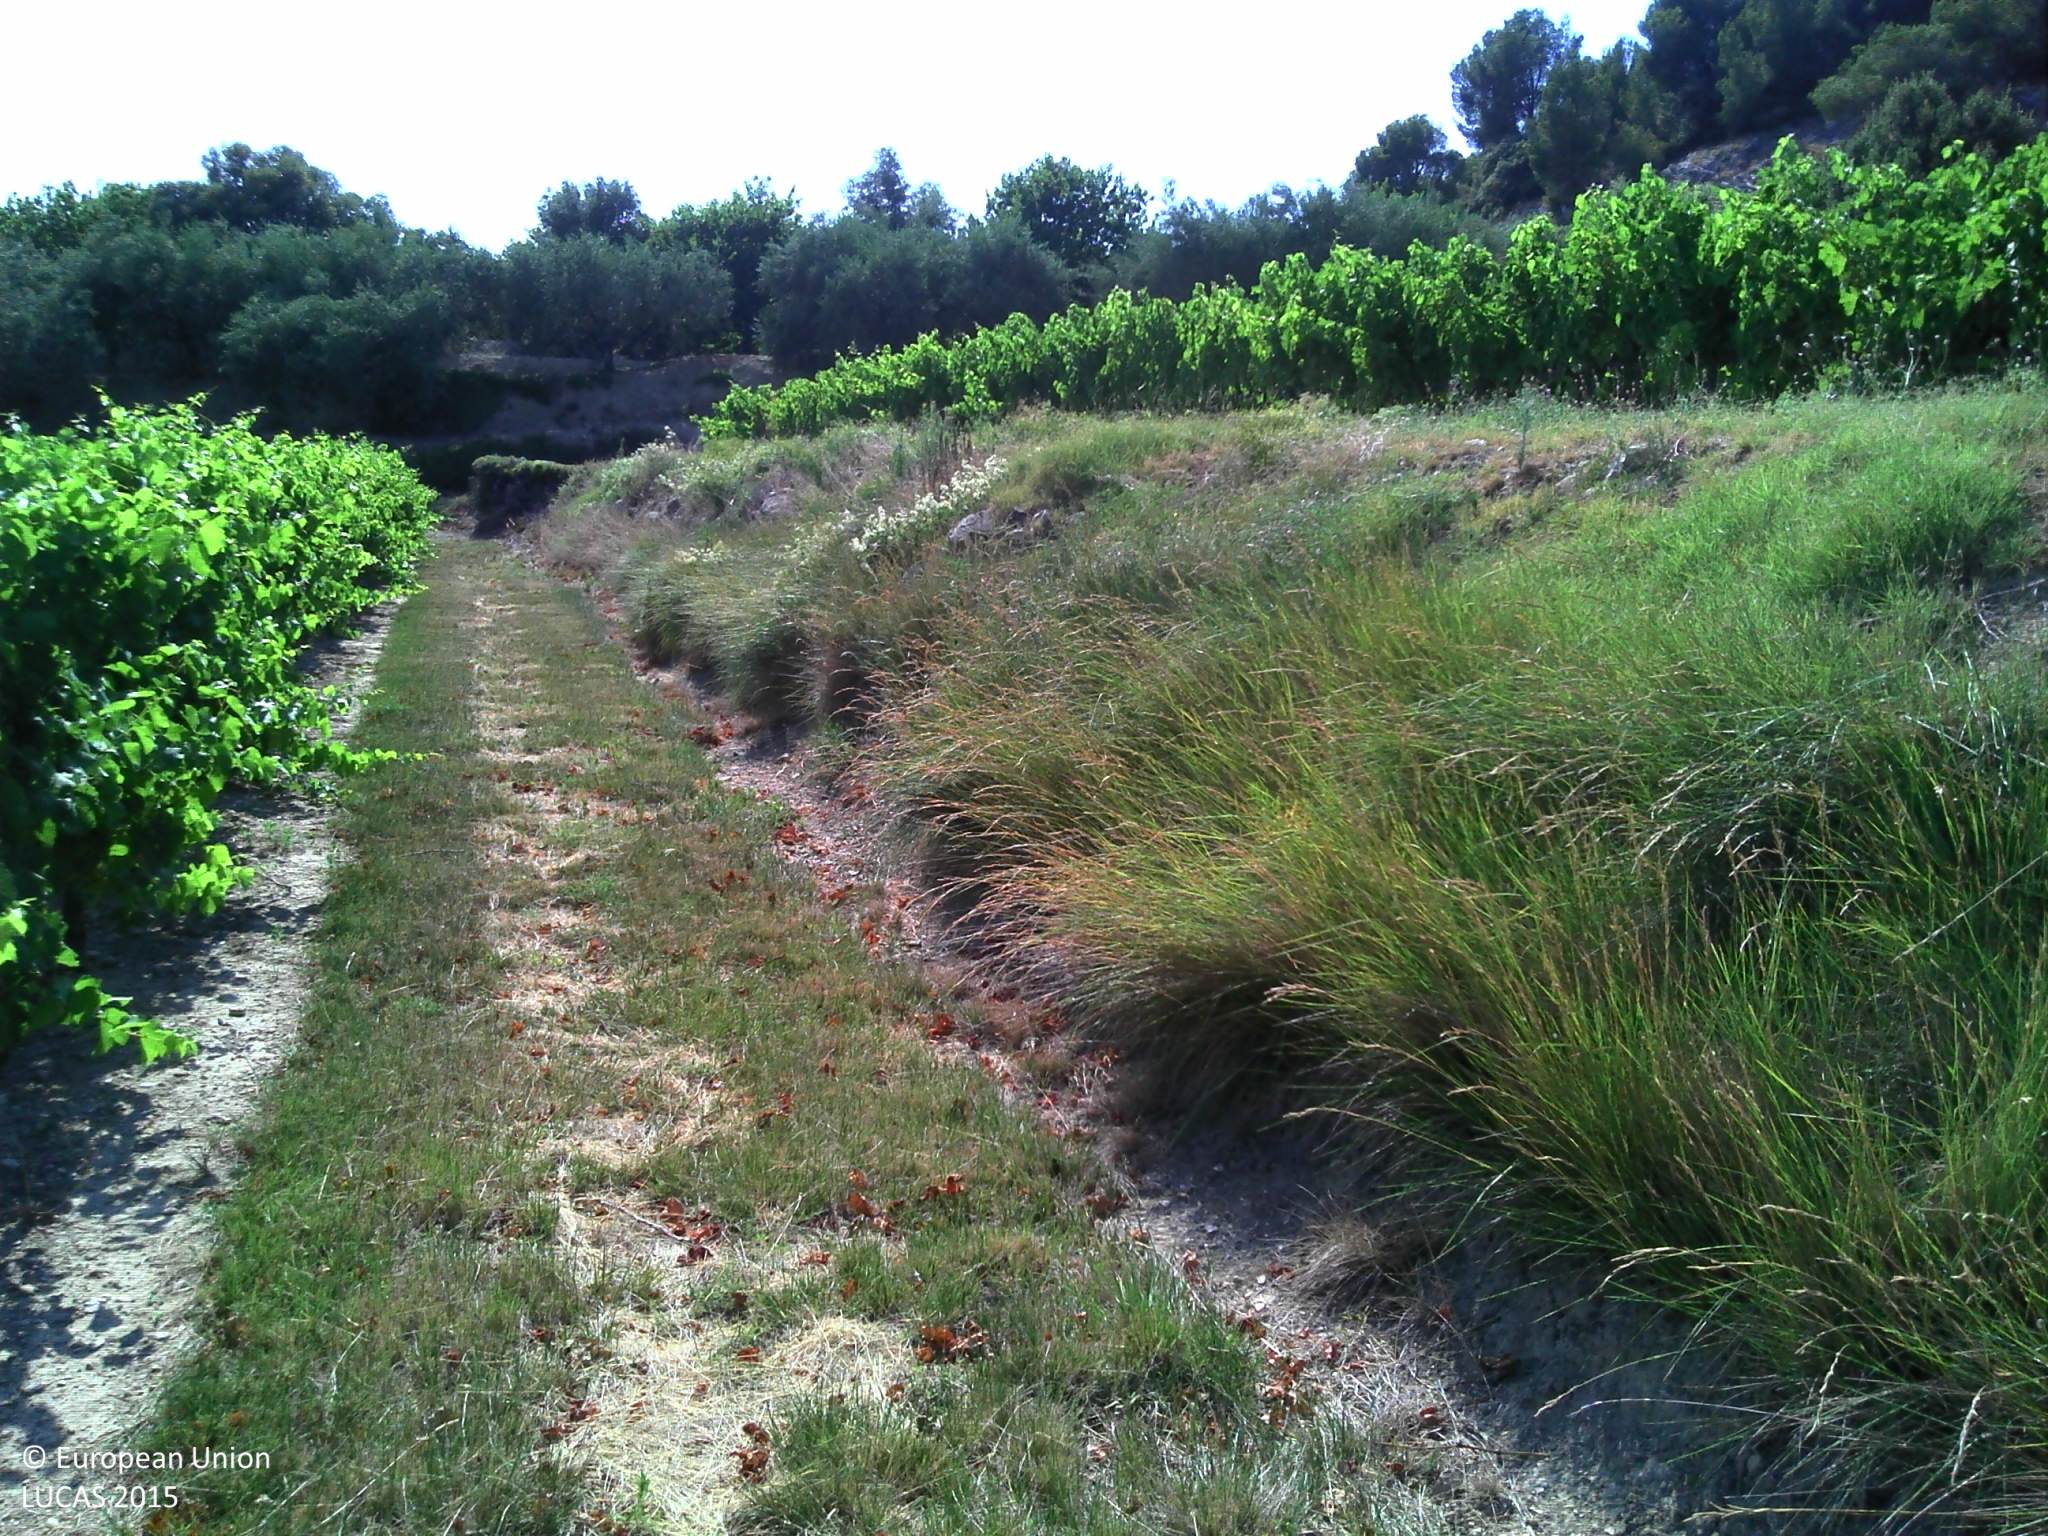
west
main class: Grassland
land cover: Grassland without tree/shrub cover
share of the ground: > 75 %
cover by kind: herbaceous plants 80 %, unconsolidated bare surface 20 %
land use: Agriculture (excluding fallow land and kitchen gardens)
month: July
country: FR
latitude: 44.1251
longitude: 5.0717
